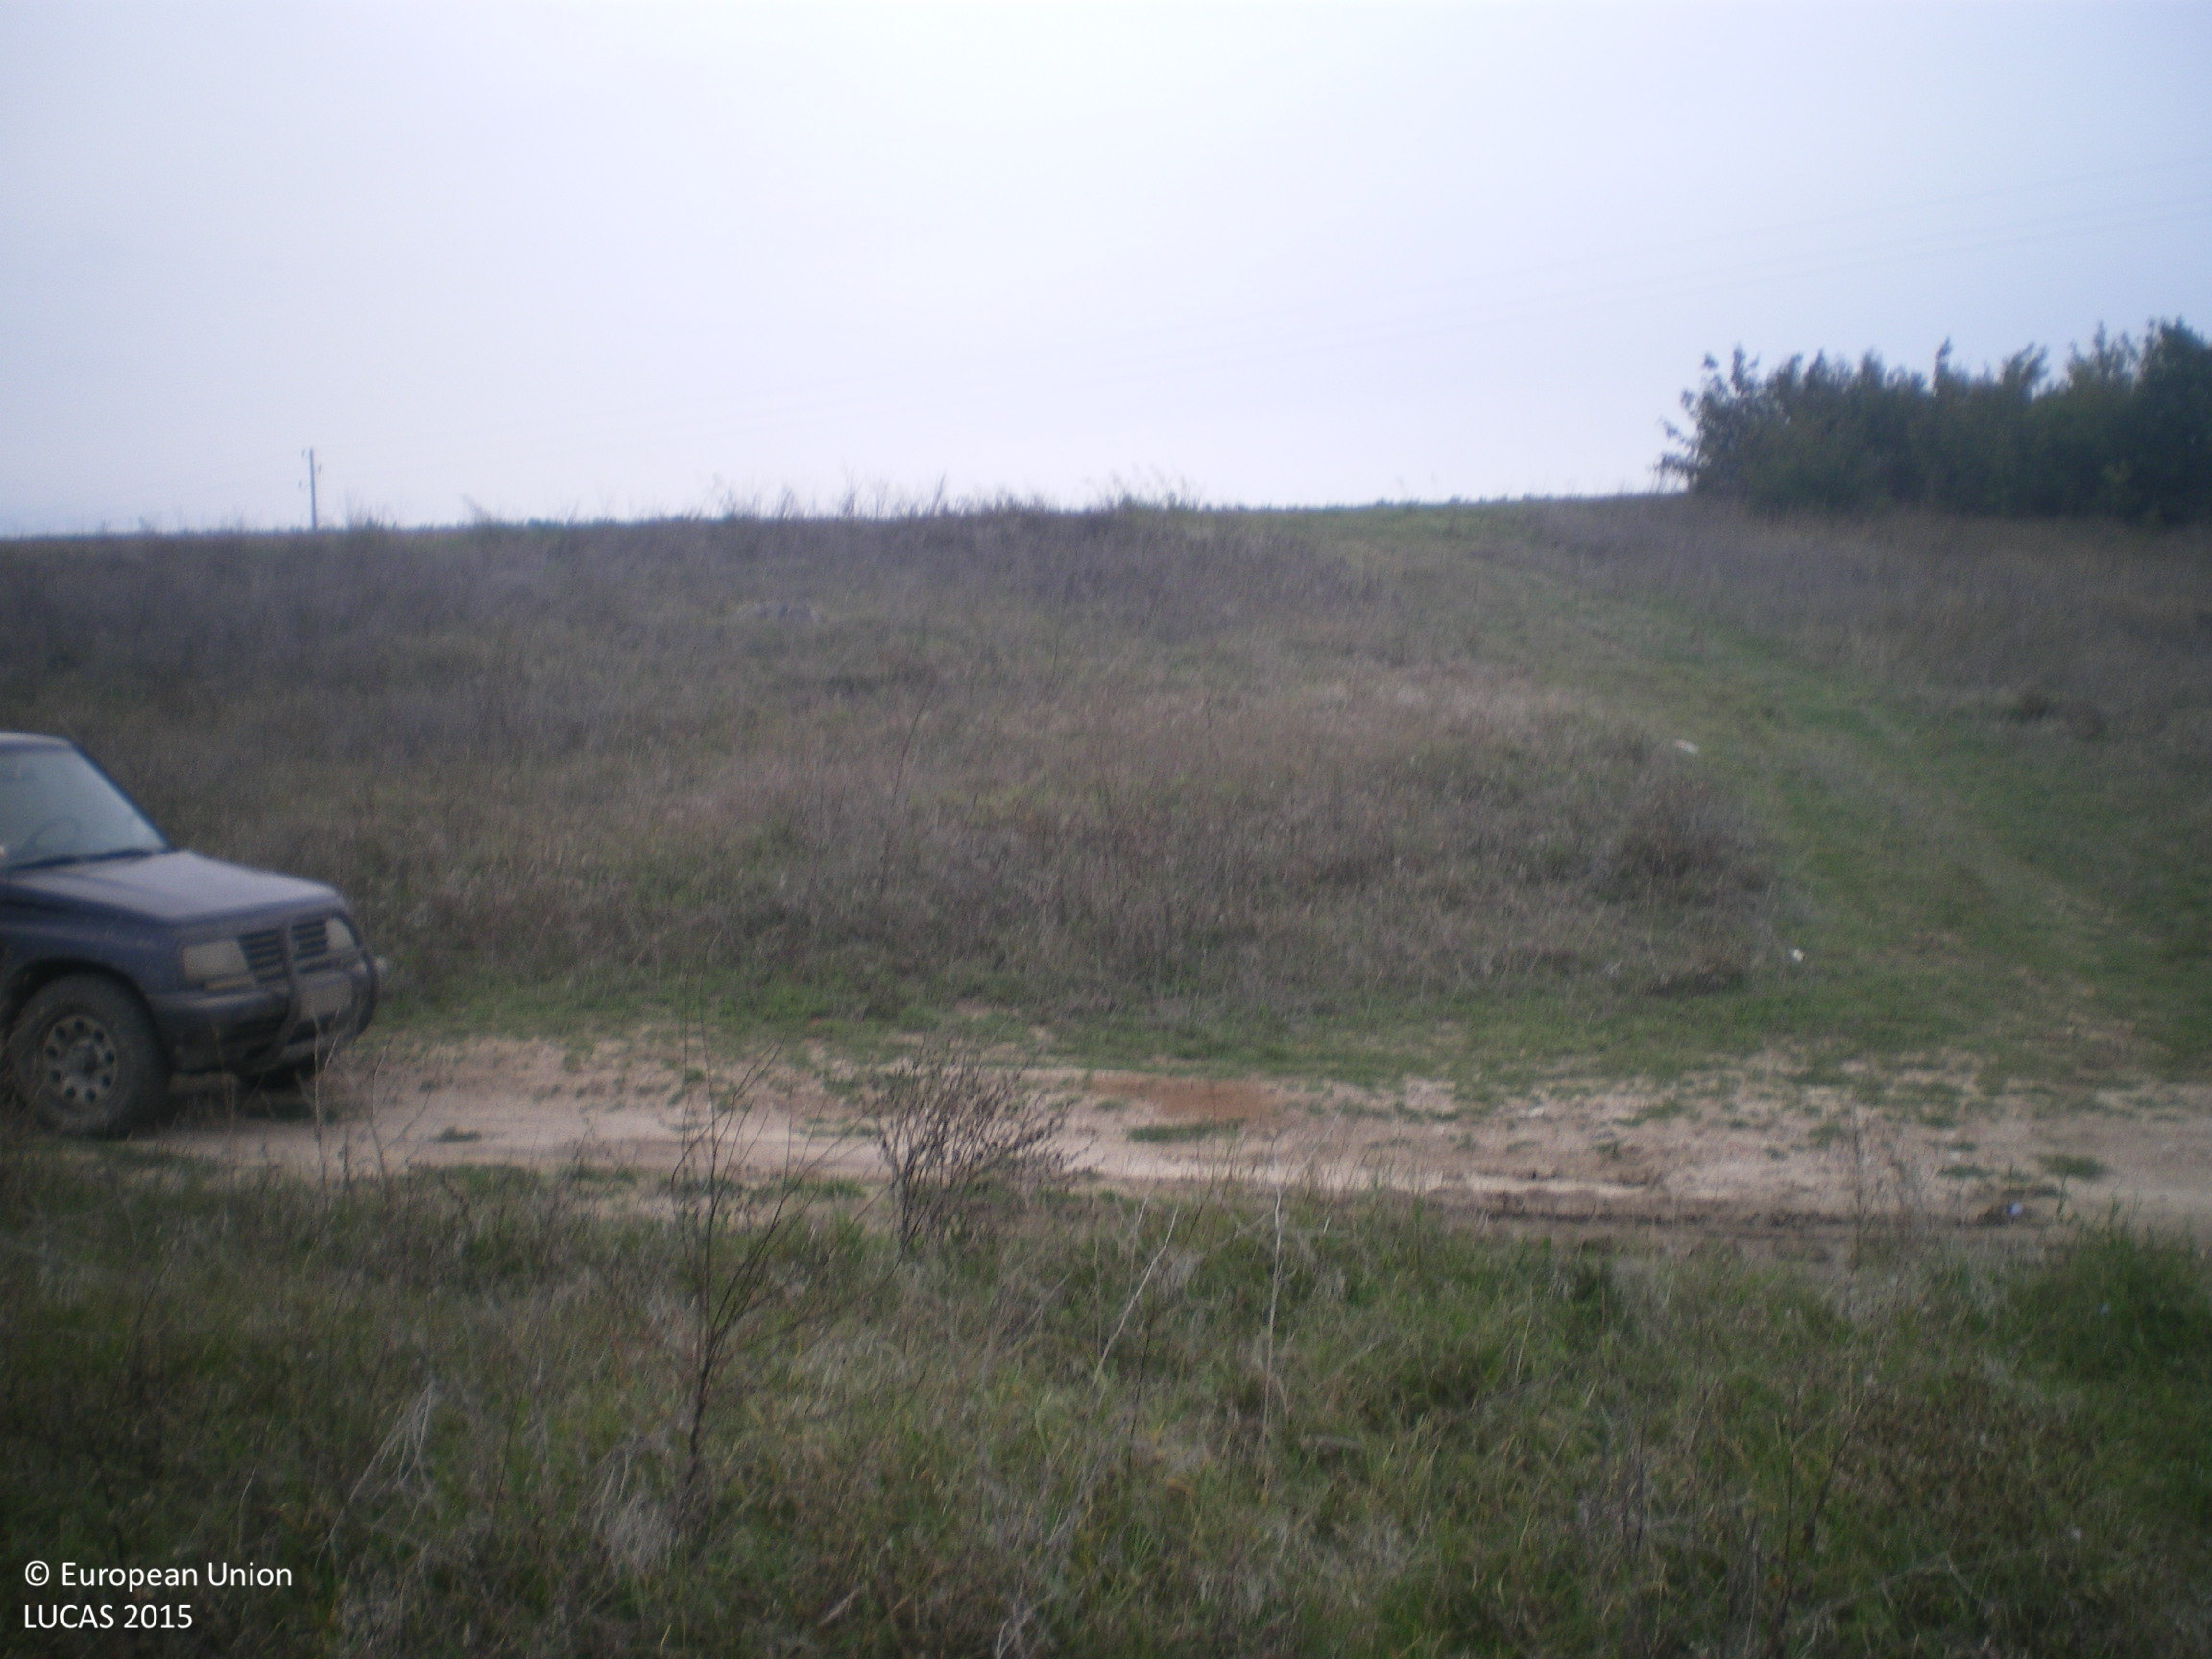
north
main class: Shrubland
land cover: Shrubland with sparse tree cover
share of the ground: > 75 %
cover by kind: shrubs 60 %, herbaceous plants 35 %, broadleaved forest trees 5 %
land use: Semi-natural and natural areas not in use
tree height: > 5 m
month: October
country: BG
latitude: 41.8046
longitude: 26.1677
